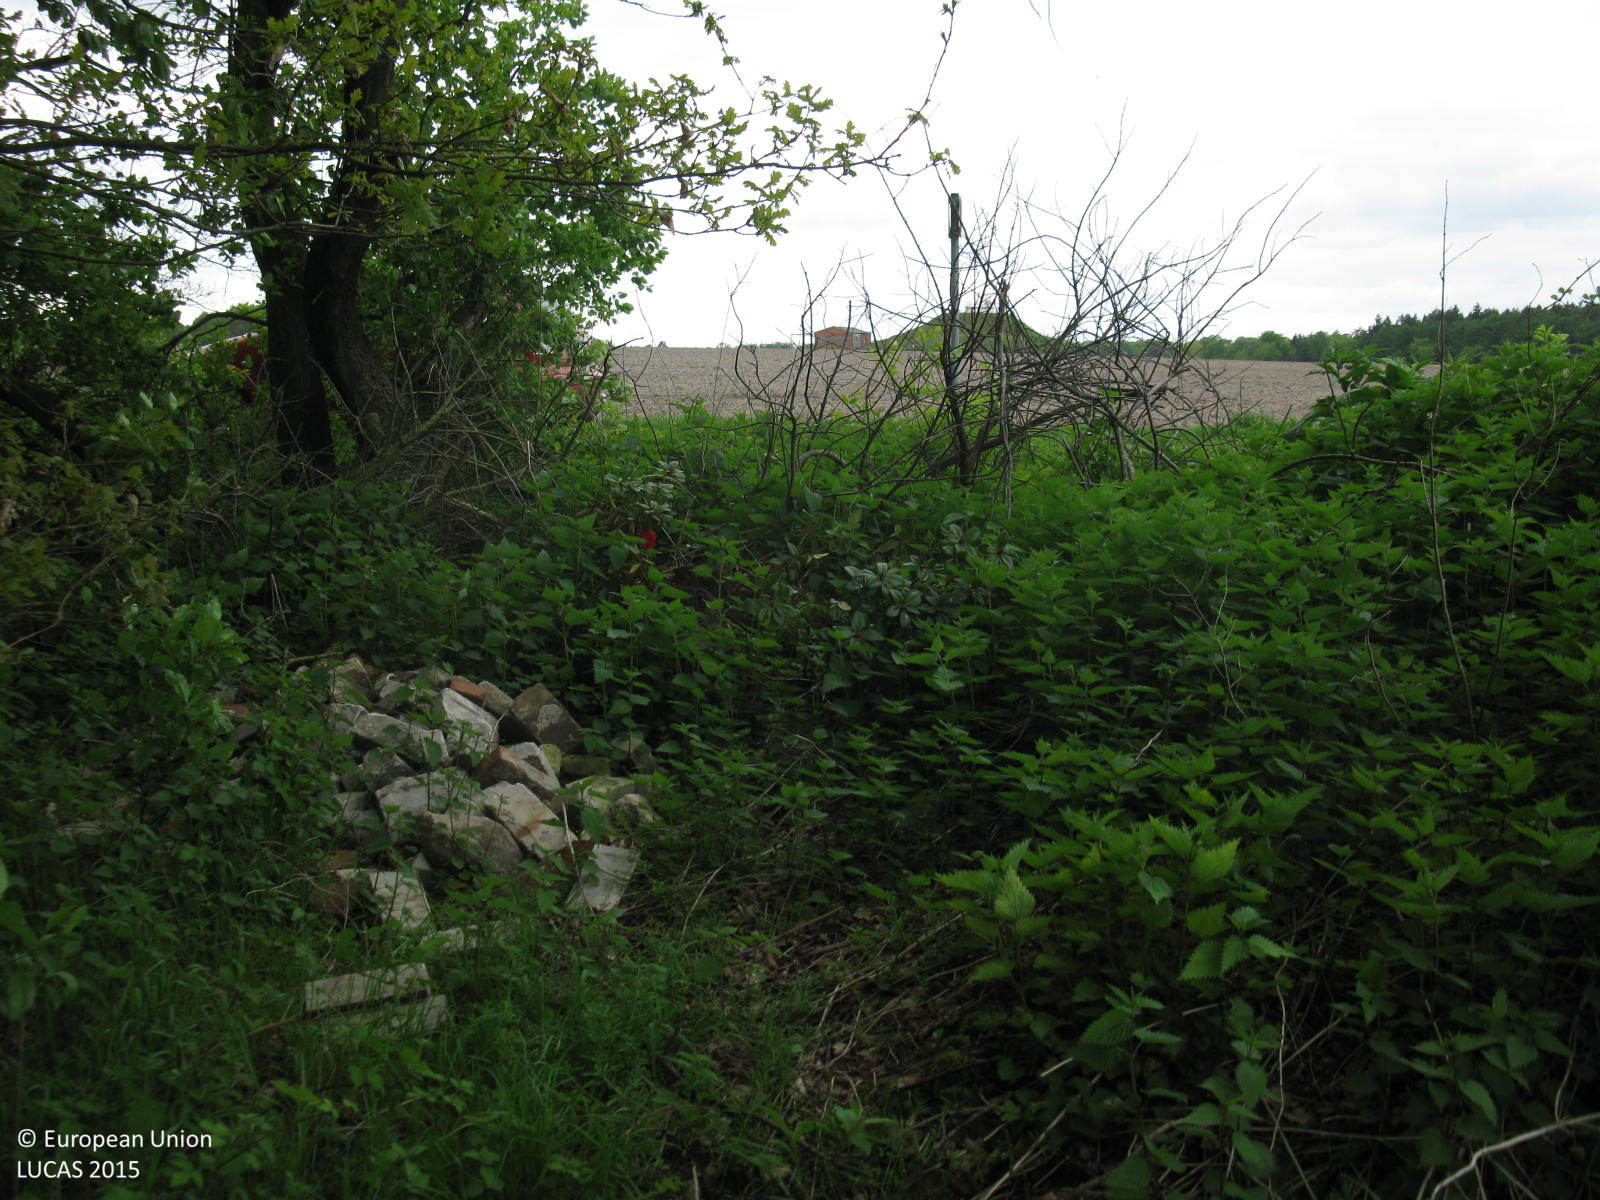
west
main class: Grassland
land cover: Spontaneously vegetated surfaces
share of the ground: > 75 %
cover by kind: herbaceous plants 100 %
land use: Semi-natural and natural areas not in use
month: May
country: DE
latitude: 52.7974
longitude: 7.3456
